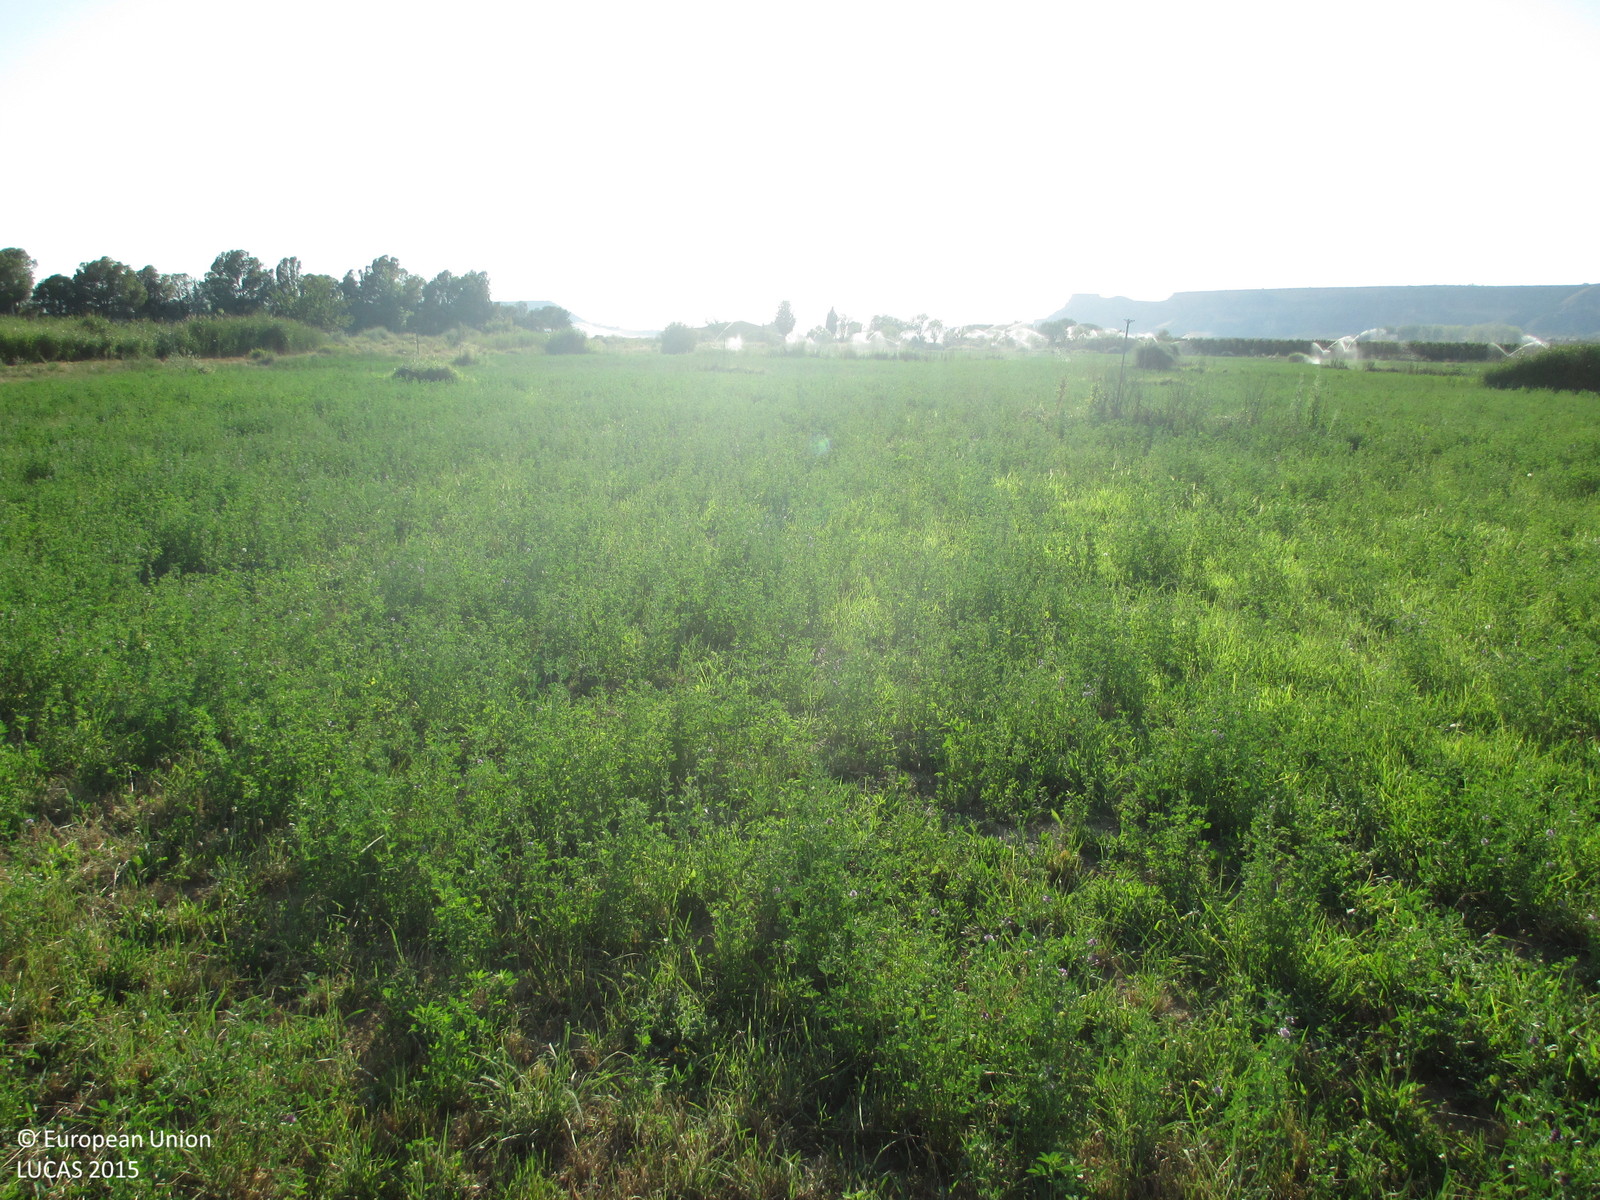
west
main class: Cropland
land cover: Lucerne
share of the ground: > 75 %
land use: Agriculture (excluding fallow land and kitchen gardens)
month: July
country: ES
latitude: 41.8354
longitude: 0.0484
